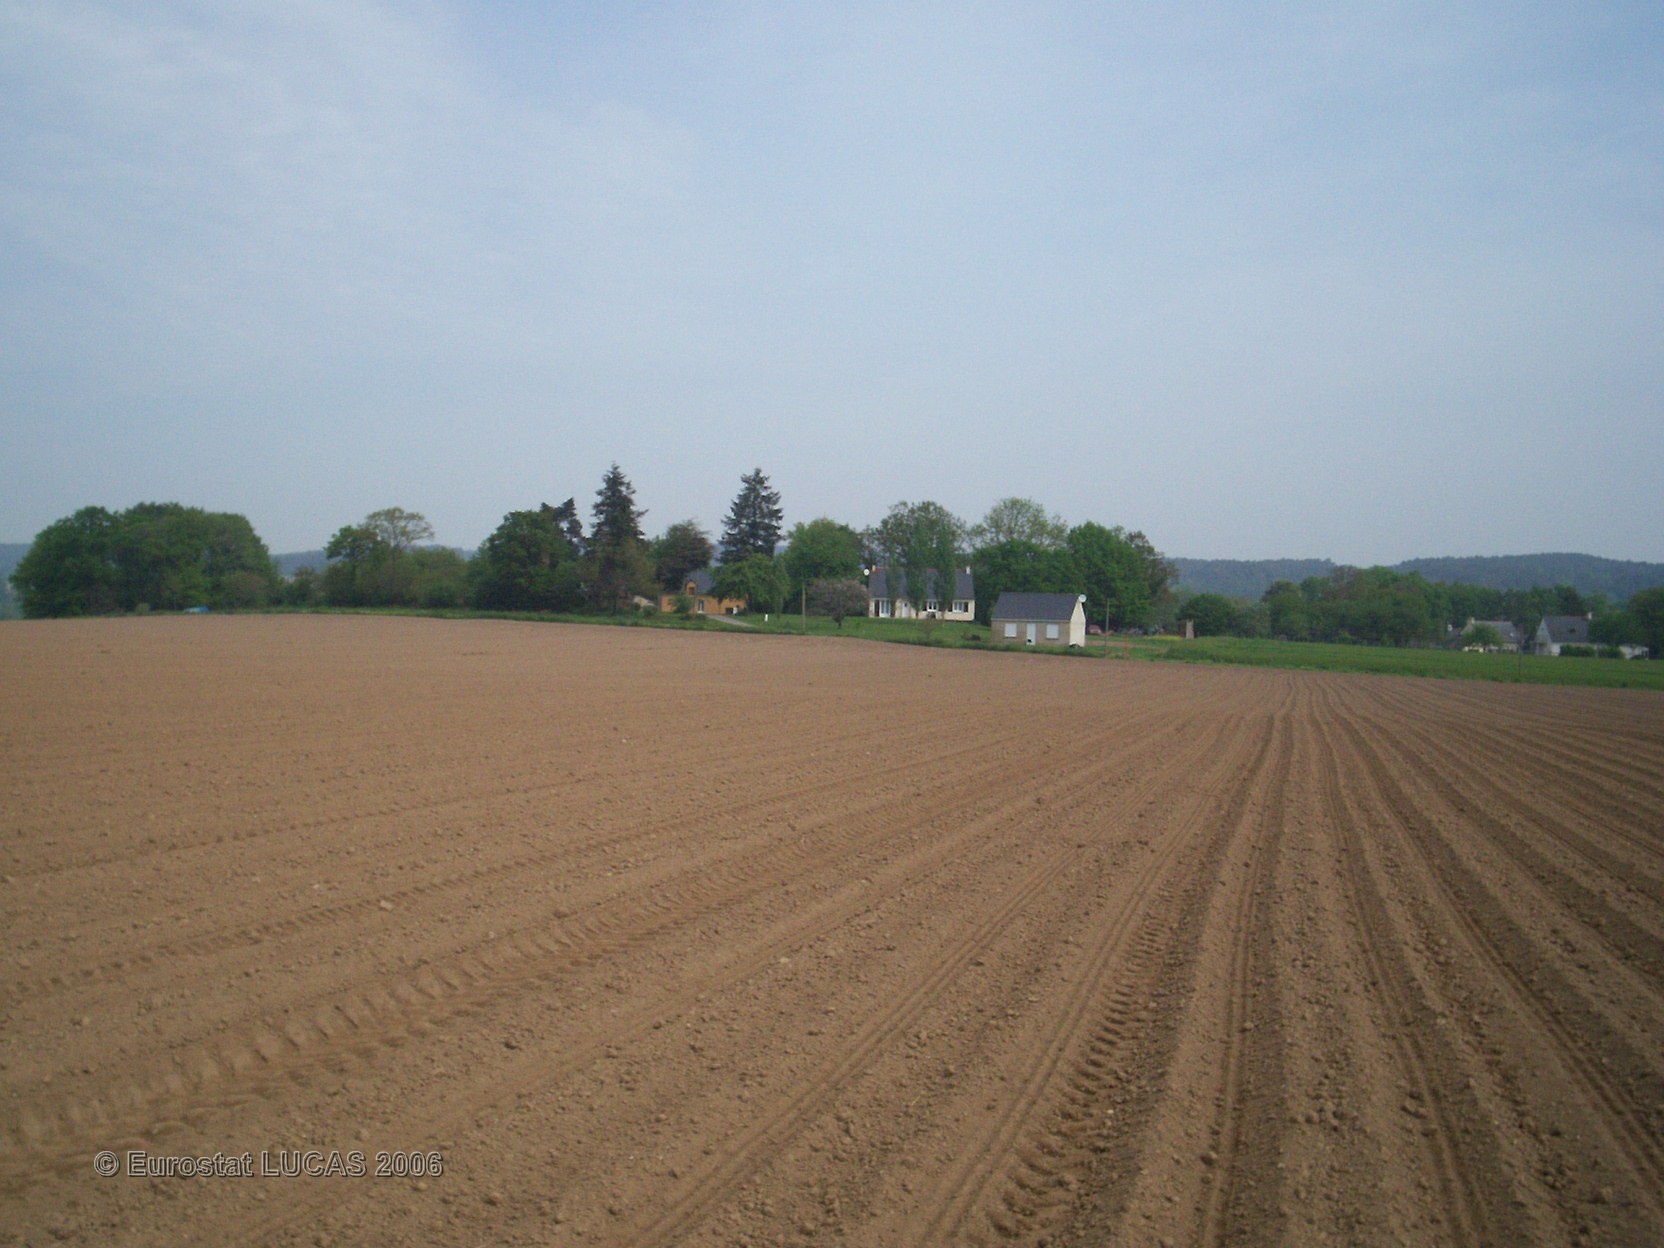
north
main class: Cropland
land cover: Maize
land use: Agriculture (excluding fallow land and kitchen gardens)
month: May
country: FR
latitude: 47.7633
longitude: -2.3438
